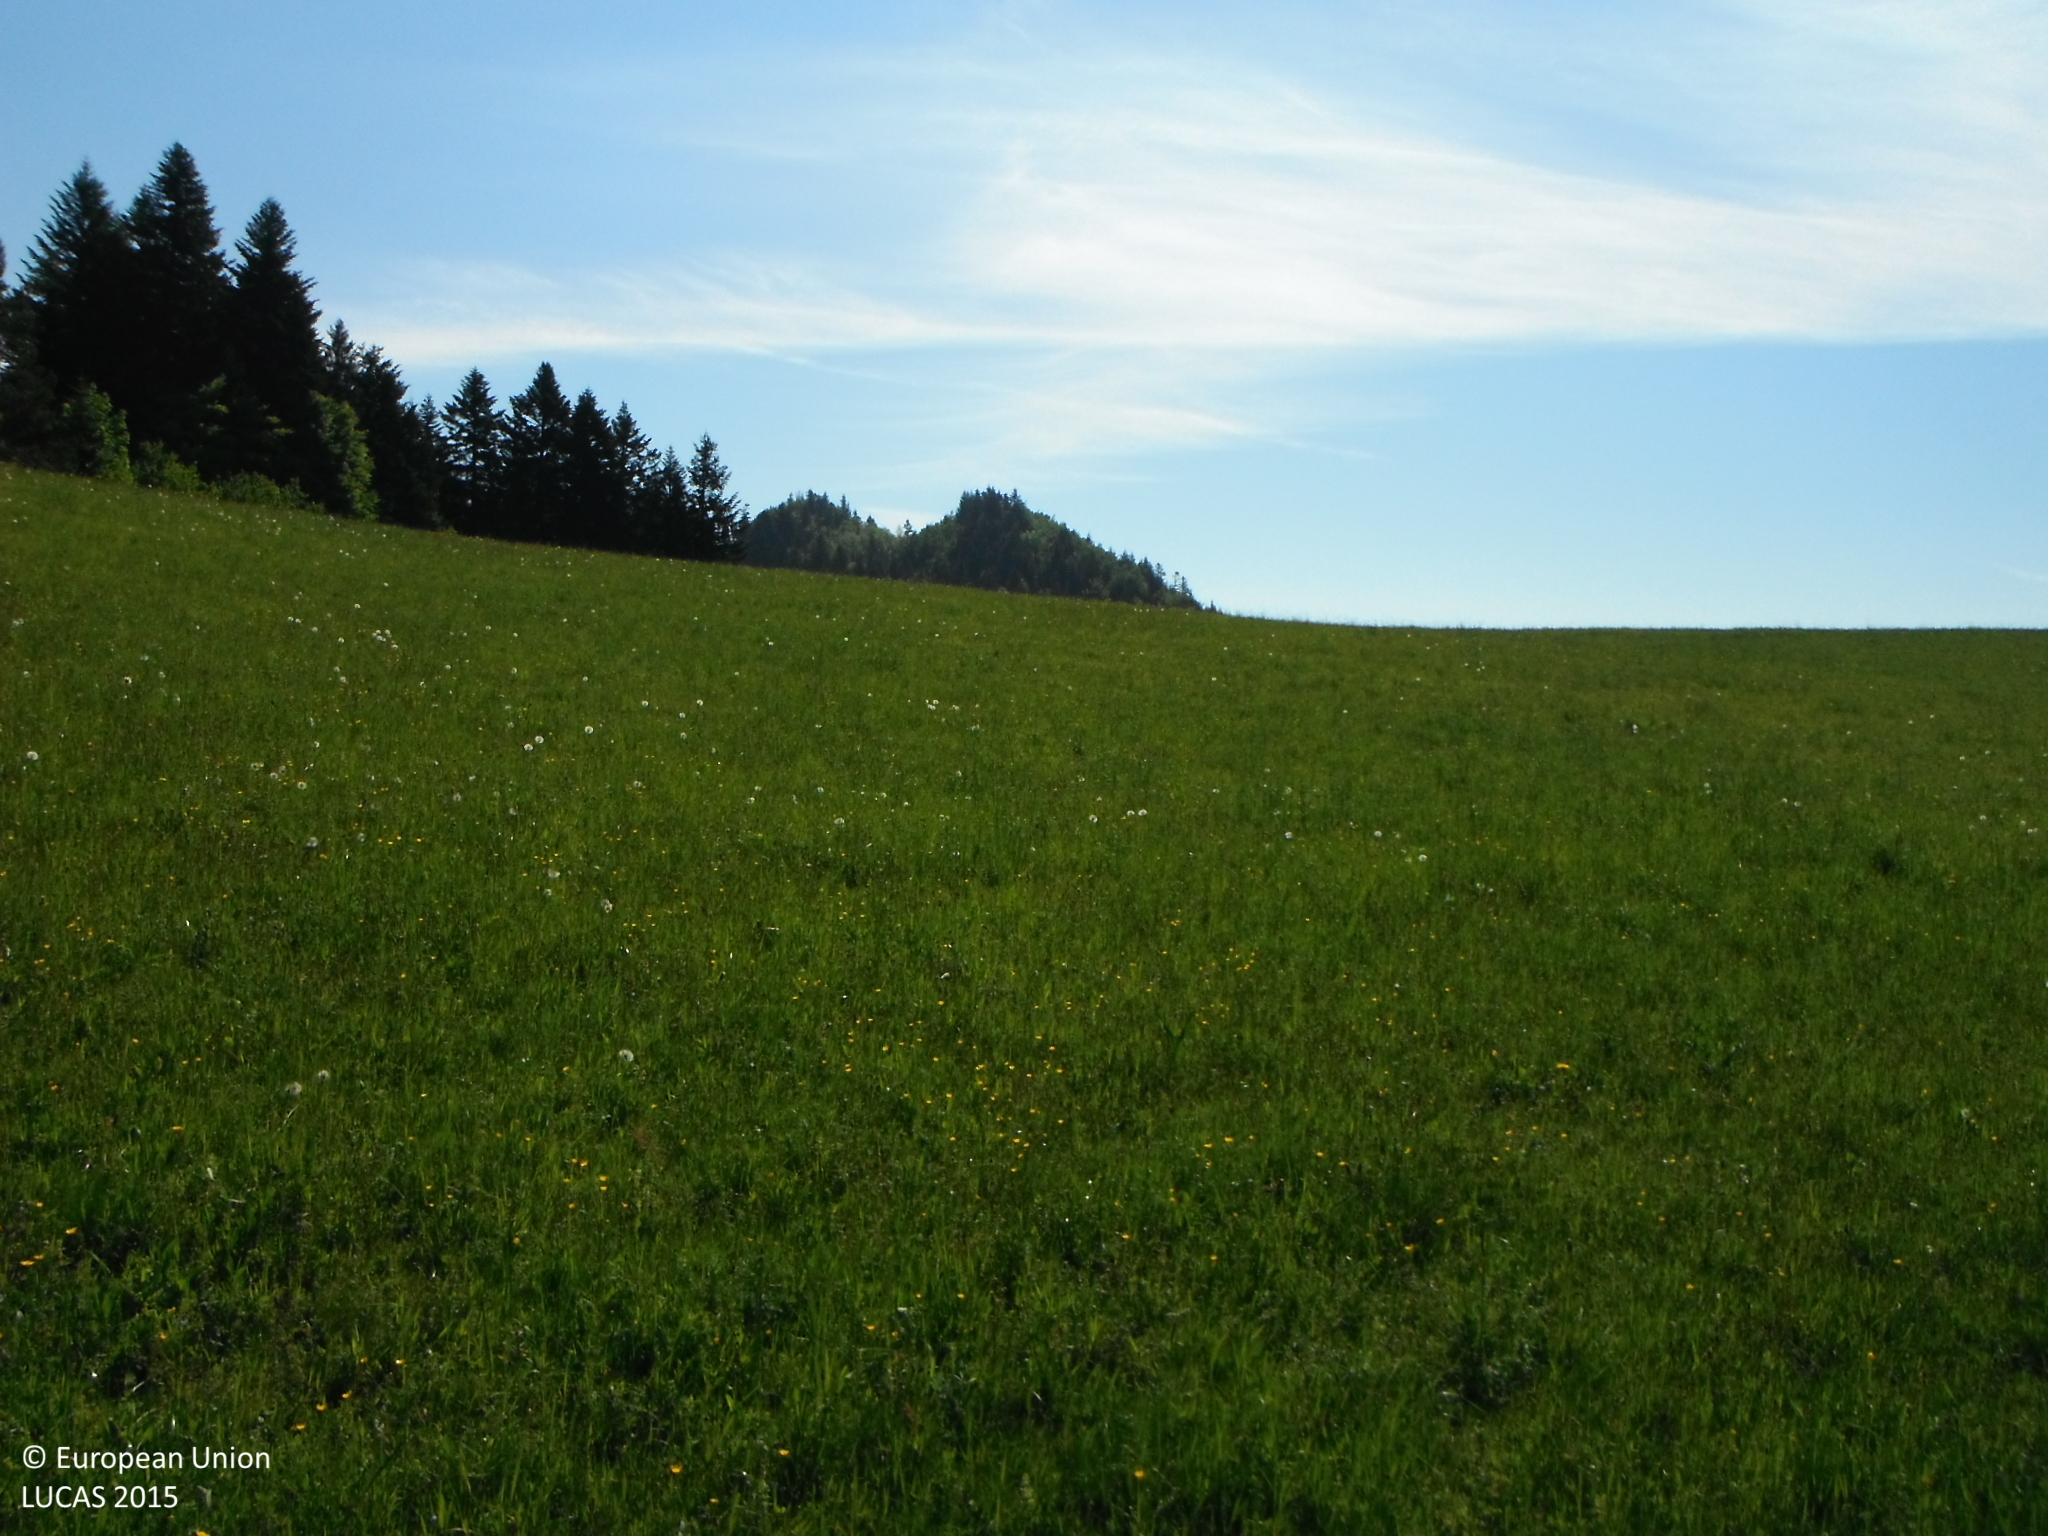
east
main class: Grassland
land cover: Grassland without tree/shrub cover
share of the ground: > 75 %
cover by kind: herbaceous plants 100 %
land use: Agriculture (excluding fallow land and kitchen gardens)
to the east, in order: Grassland without tree/shrub cover; Tracks; Grassland without tree/shrub cover; Other mixed woodland
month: May
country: SK
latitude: 49.3648
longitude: 20.5716
